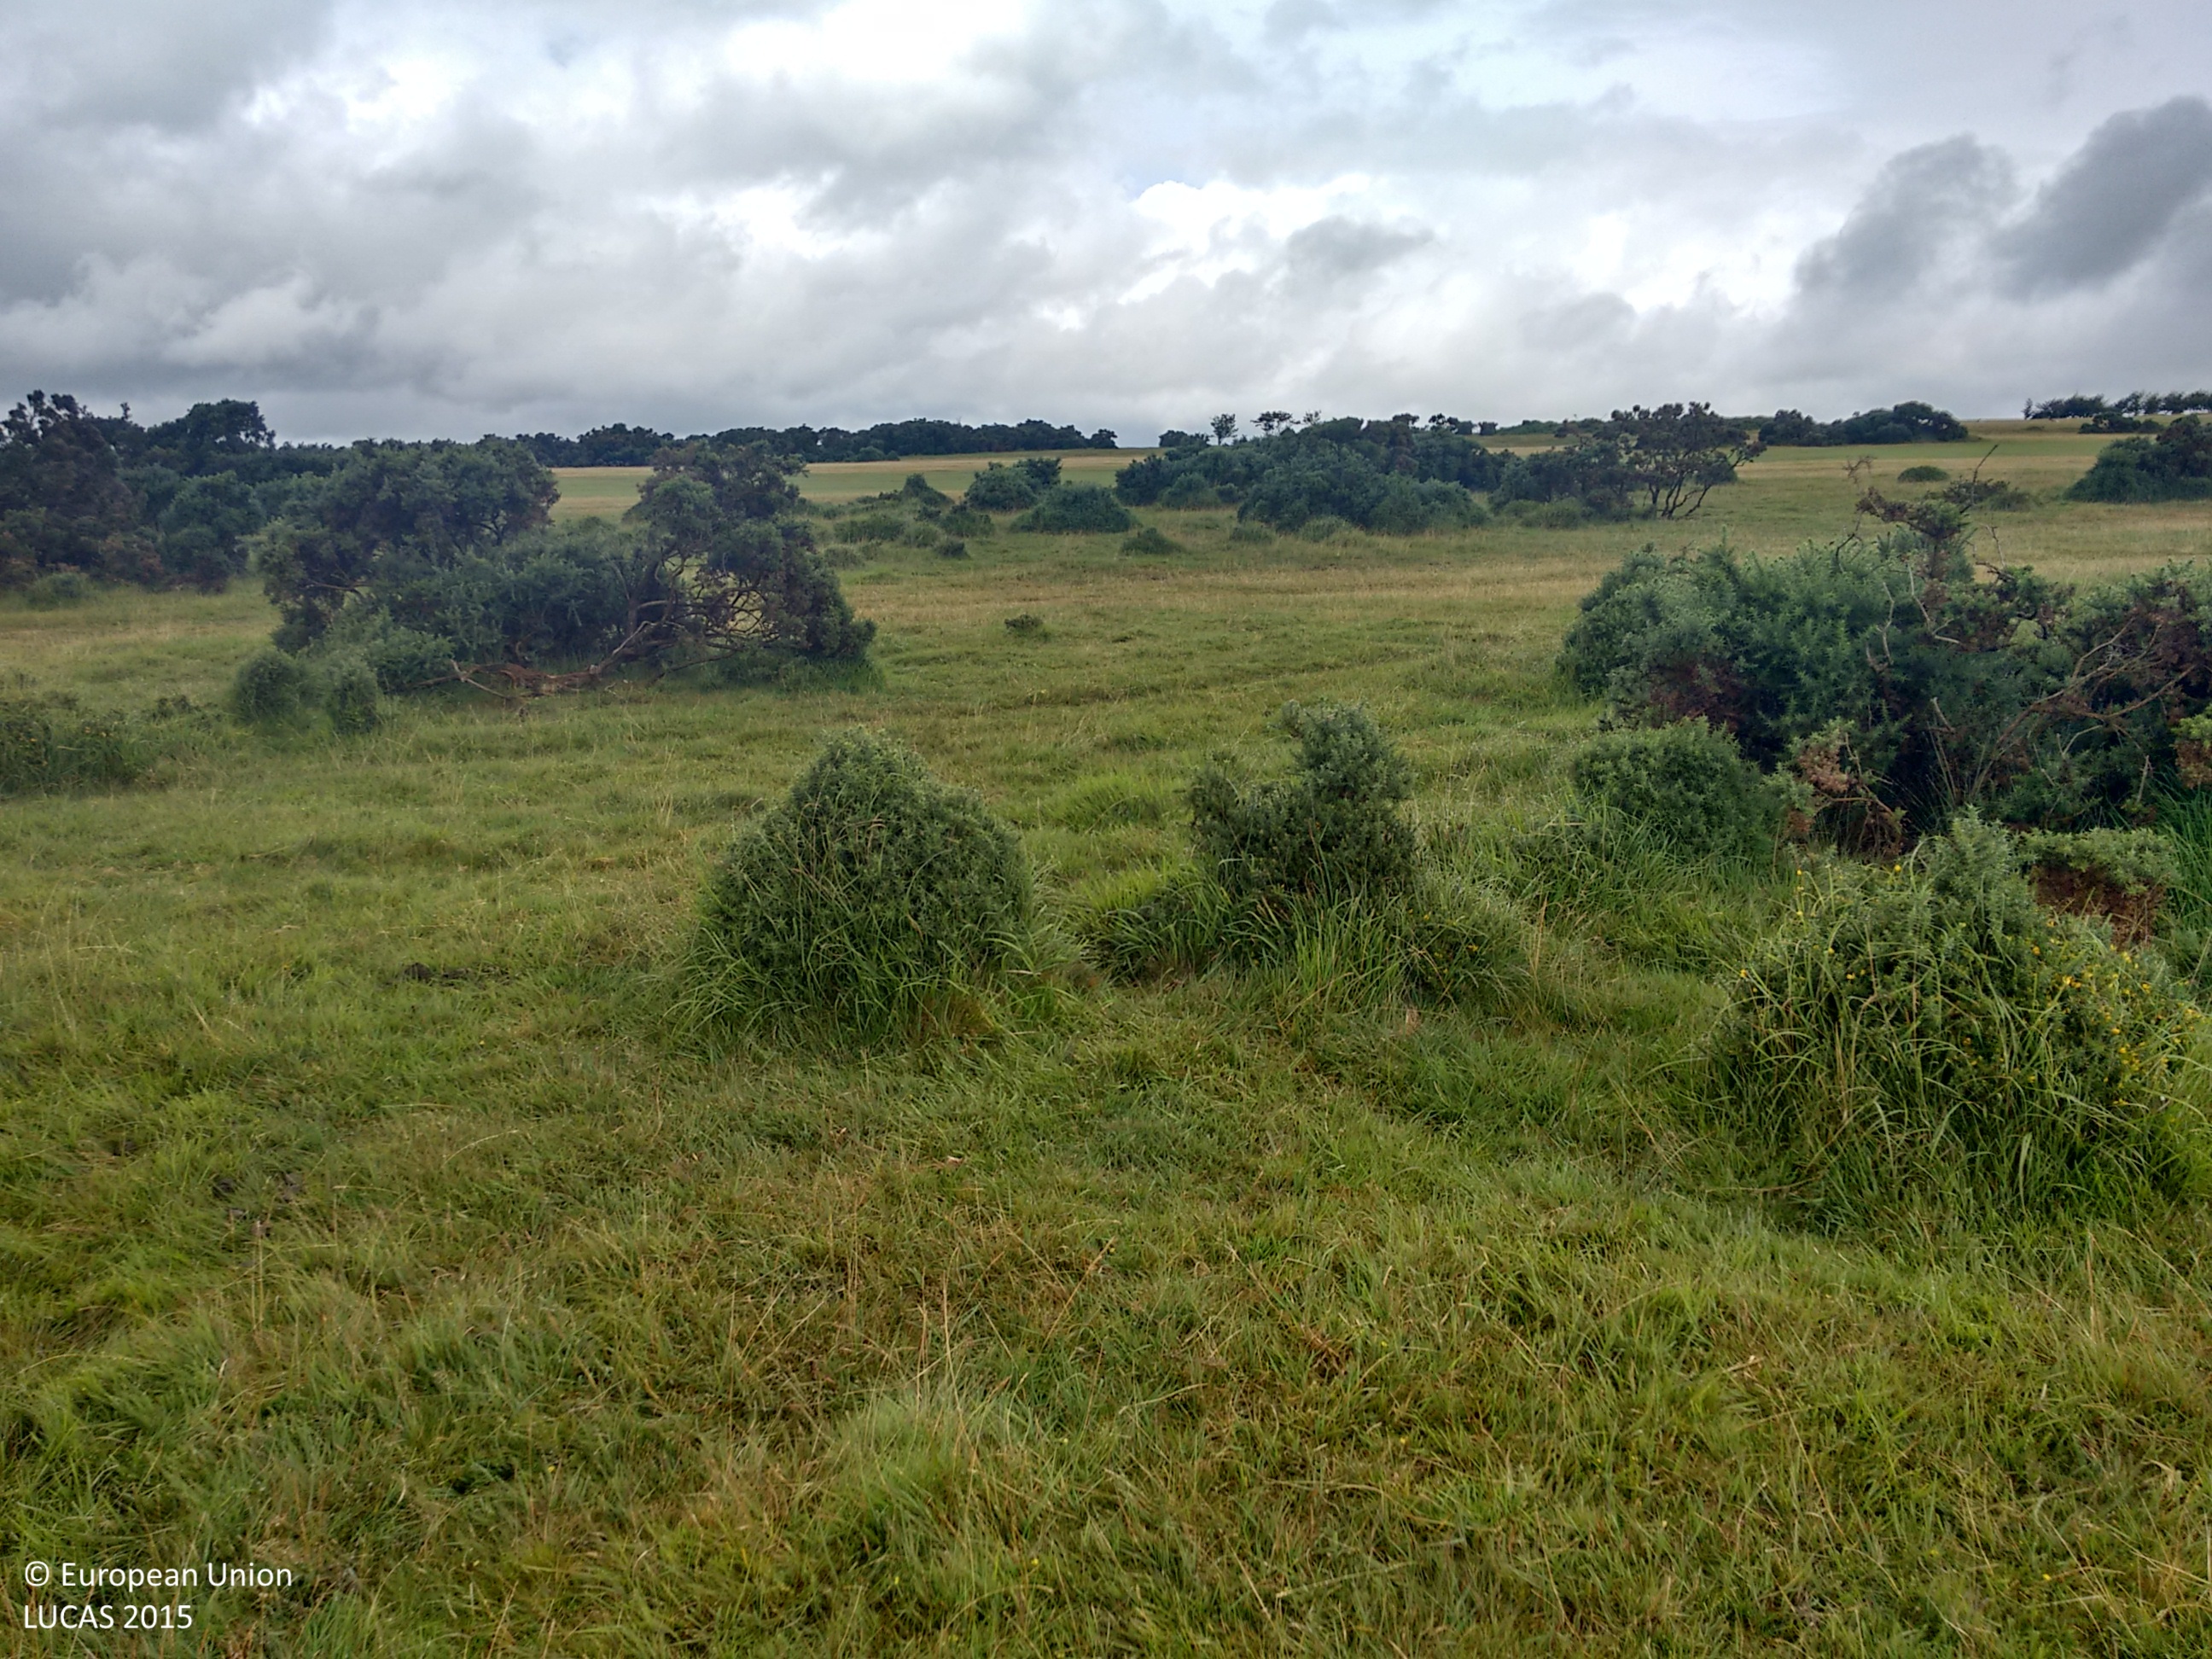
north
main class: Shrubland
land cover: Shrubland without tree cover
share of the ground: > 75 %
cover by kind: herbaceous plants 75 %, shrubs 25 %
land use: Agriculture (excluding fallow land and kitchen gardens)
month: August
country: GB
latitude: 50.5429
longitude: -4.1084
